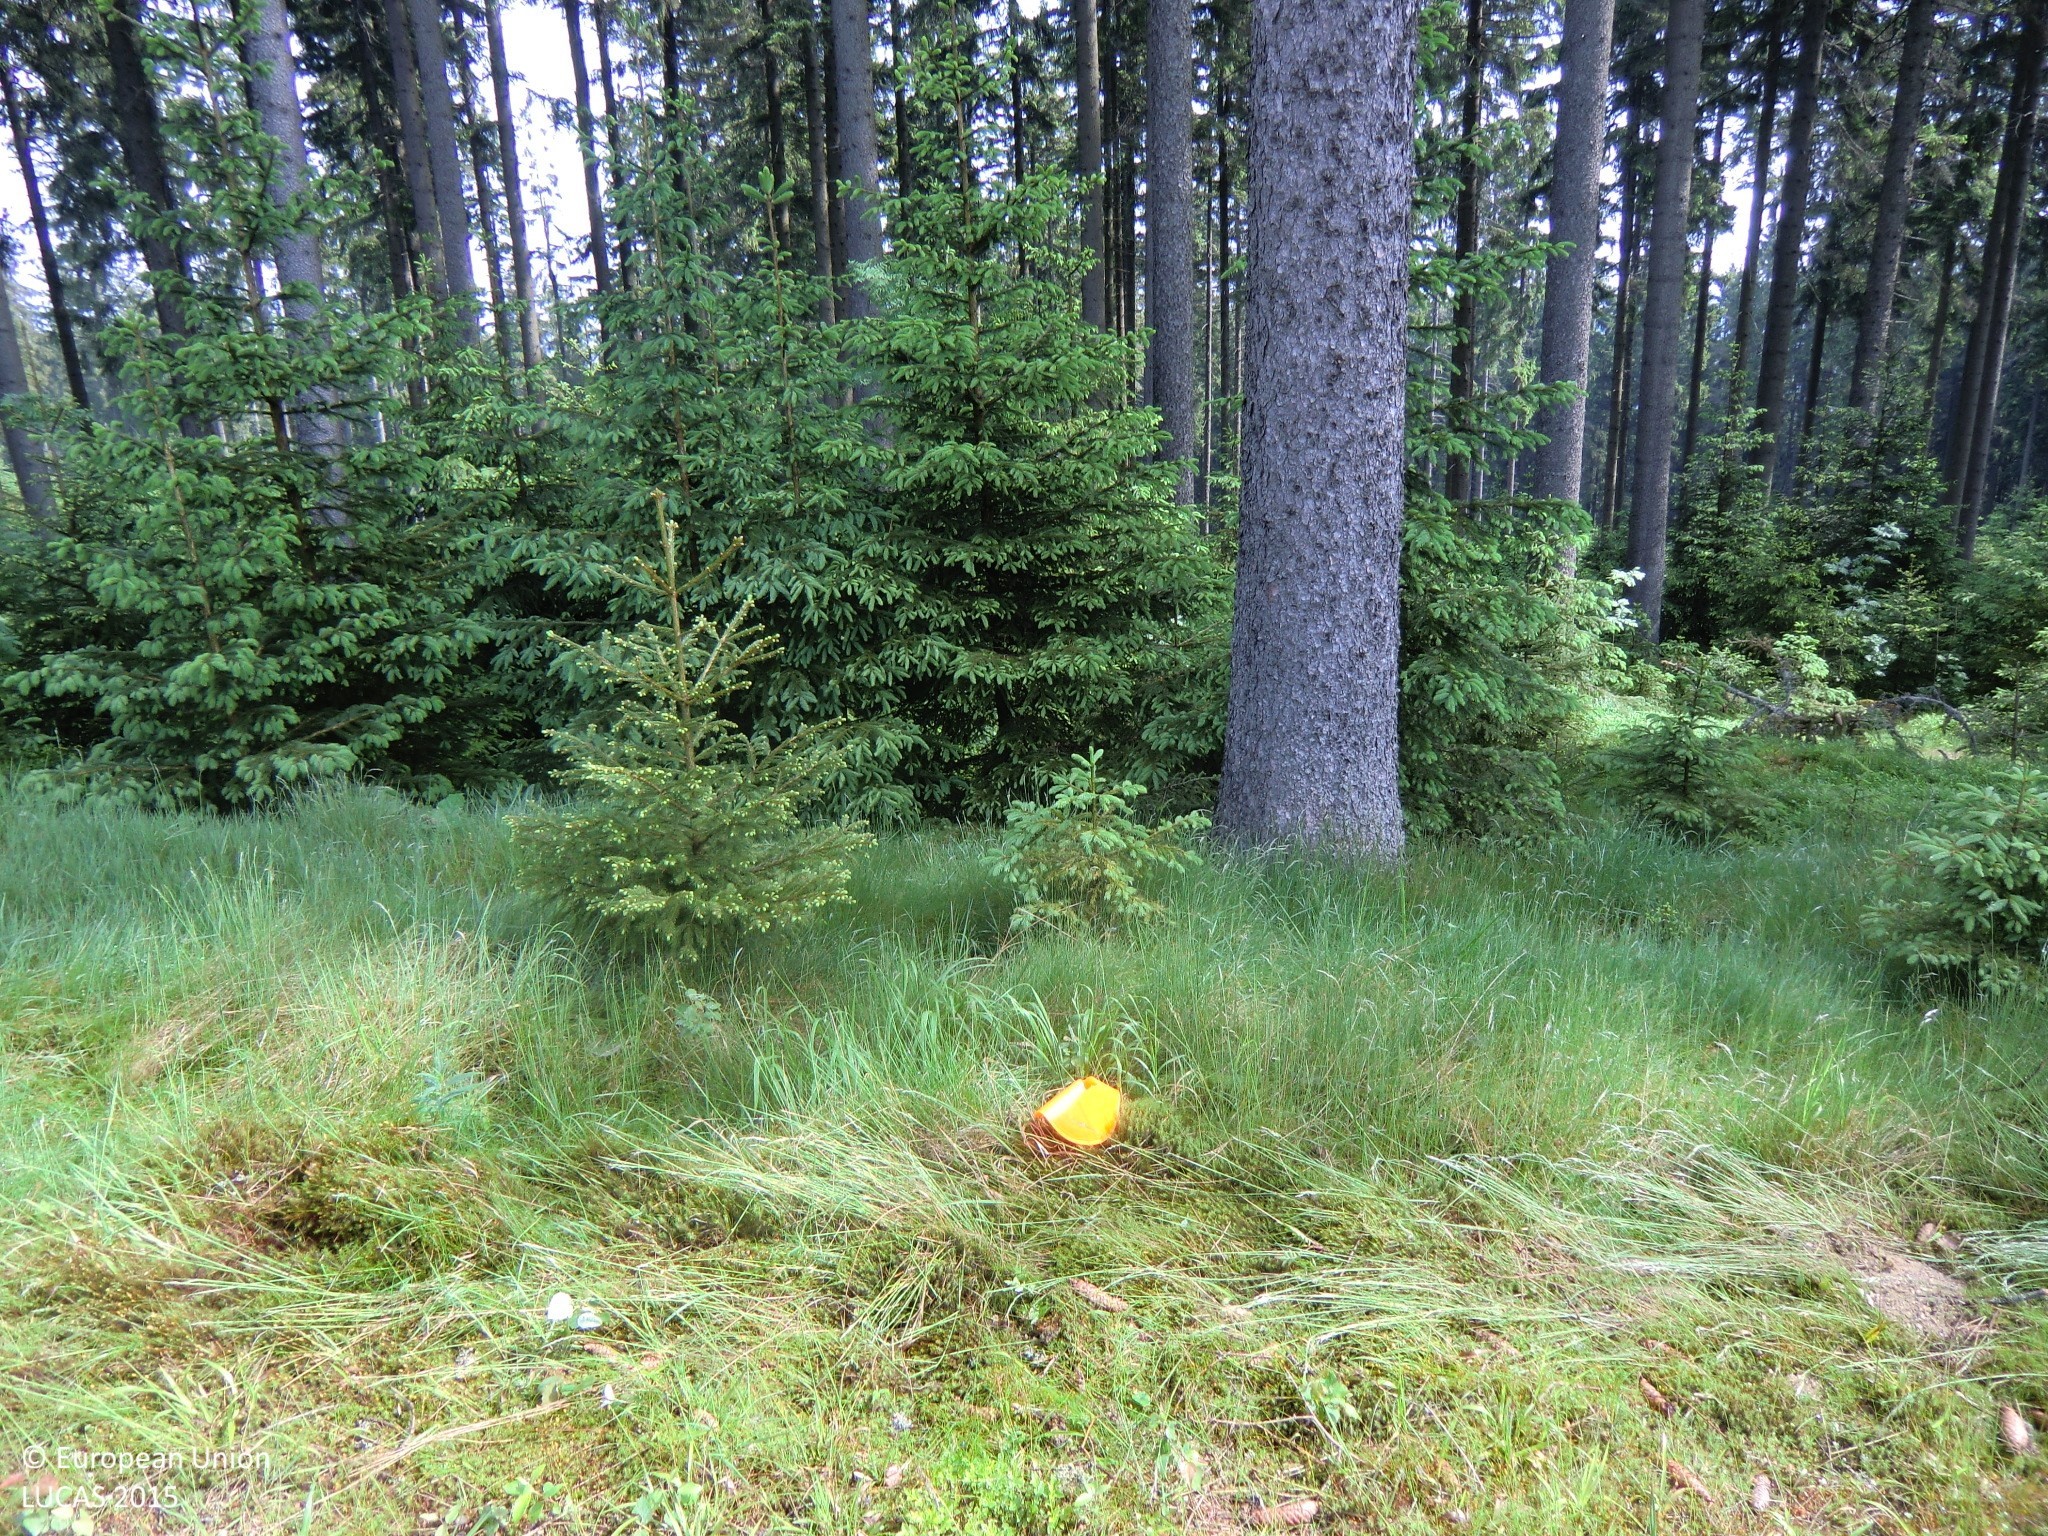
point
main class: Woodland
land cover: Other coniferous woodland
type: hemiboreal forest and nemoral coniferous forest and mixed broadleaved-coniferous forest
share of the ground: > 75 %
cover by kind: coniferous forest trees 75 %, herbaceous plants 15 %, lichens and mosses 10 %
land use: Forestry
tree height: > 5 m
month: June
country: AT
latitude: 48.6085
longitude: 14.7346
